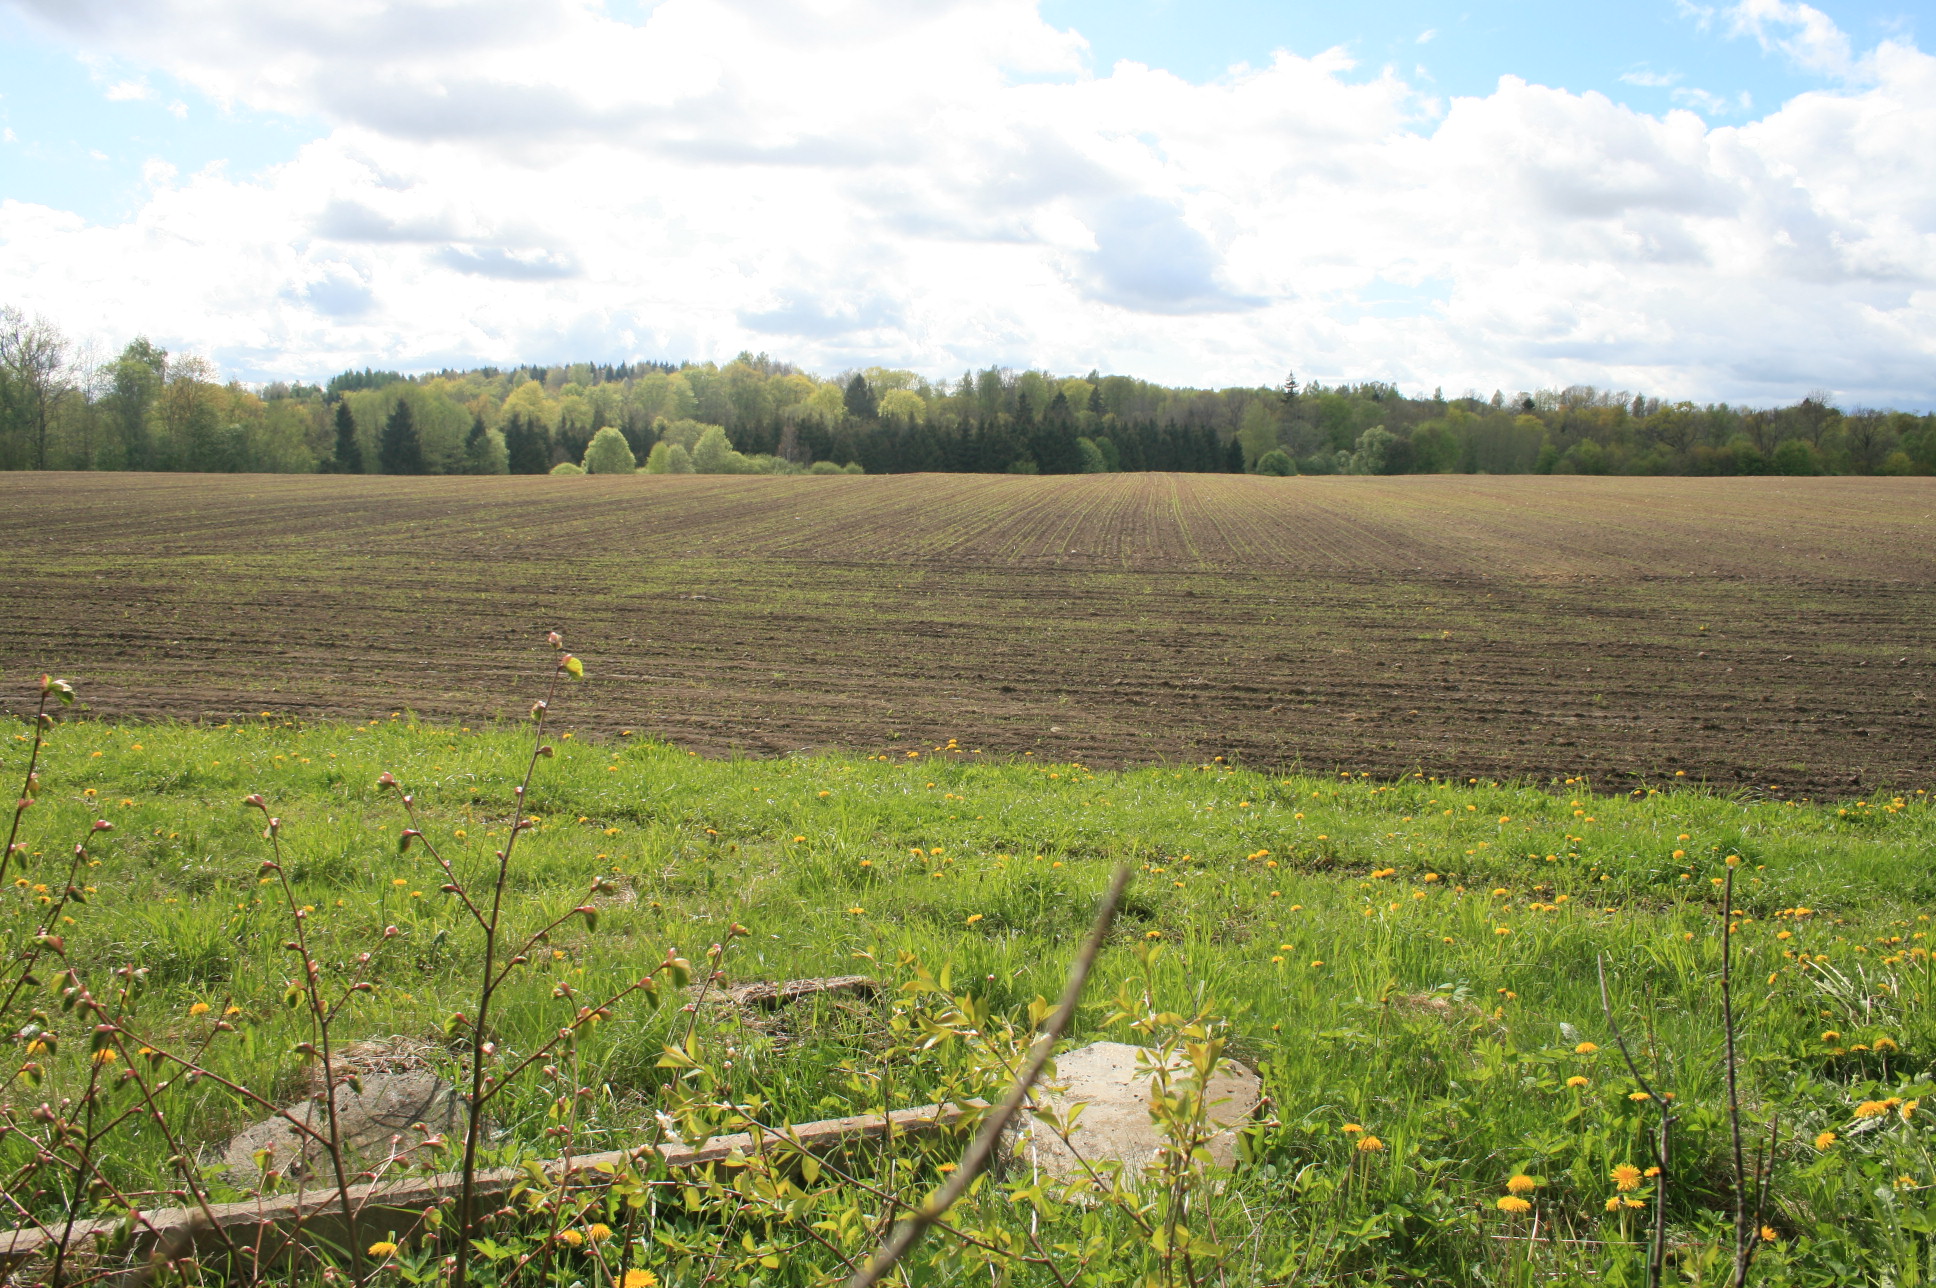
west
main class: Woodland
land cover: Spruce dominated mixed woodland
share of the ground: > 75 %
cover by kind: coniferous forest trees 55 %, broadleaved forest trees 45 %
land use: Residential
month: May
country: LT
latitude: 56.2167
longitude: 22.0648
